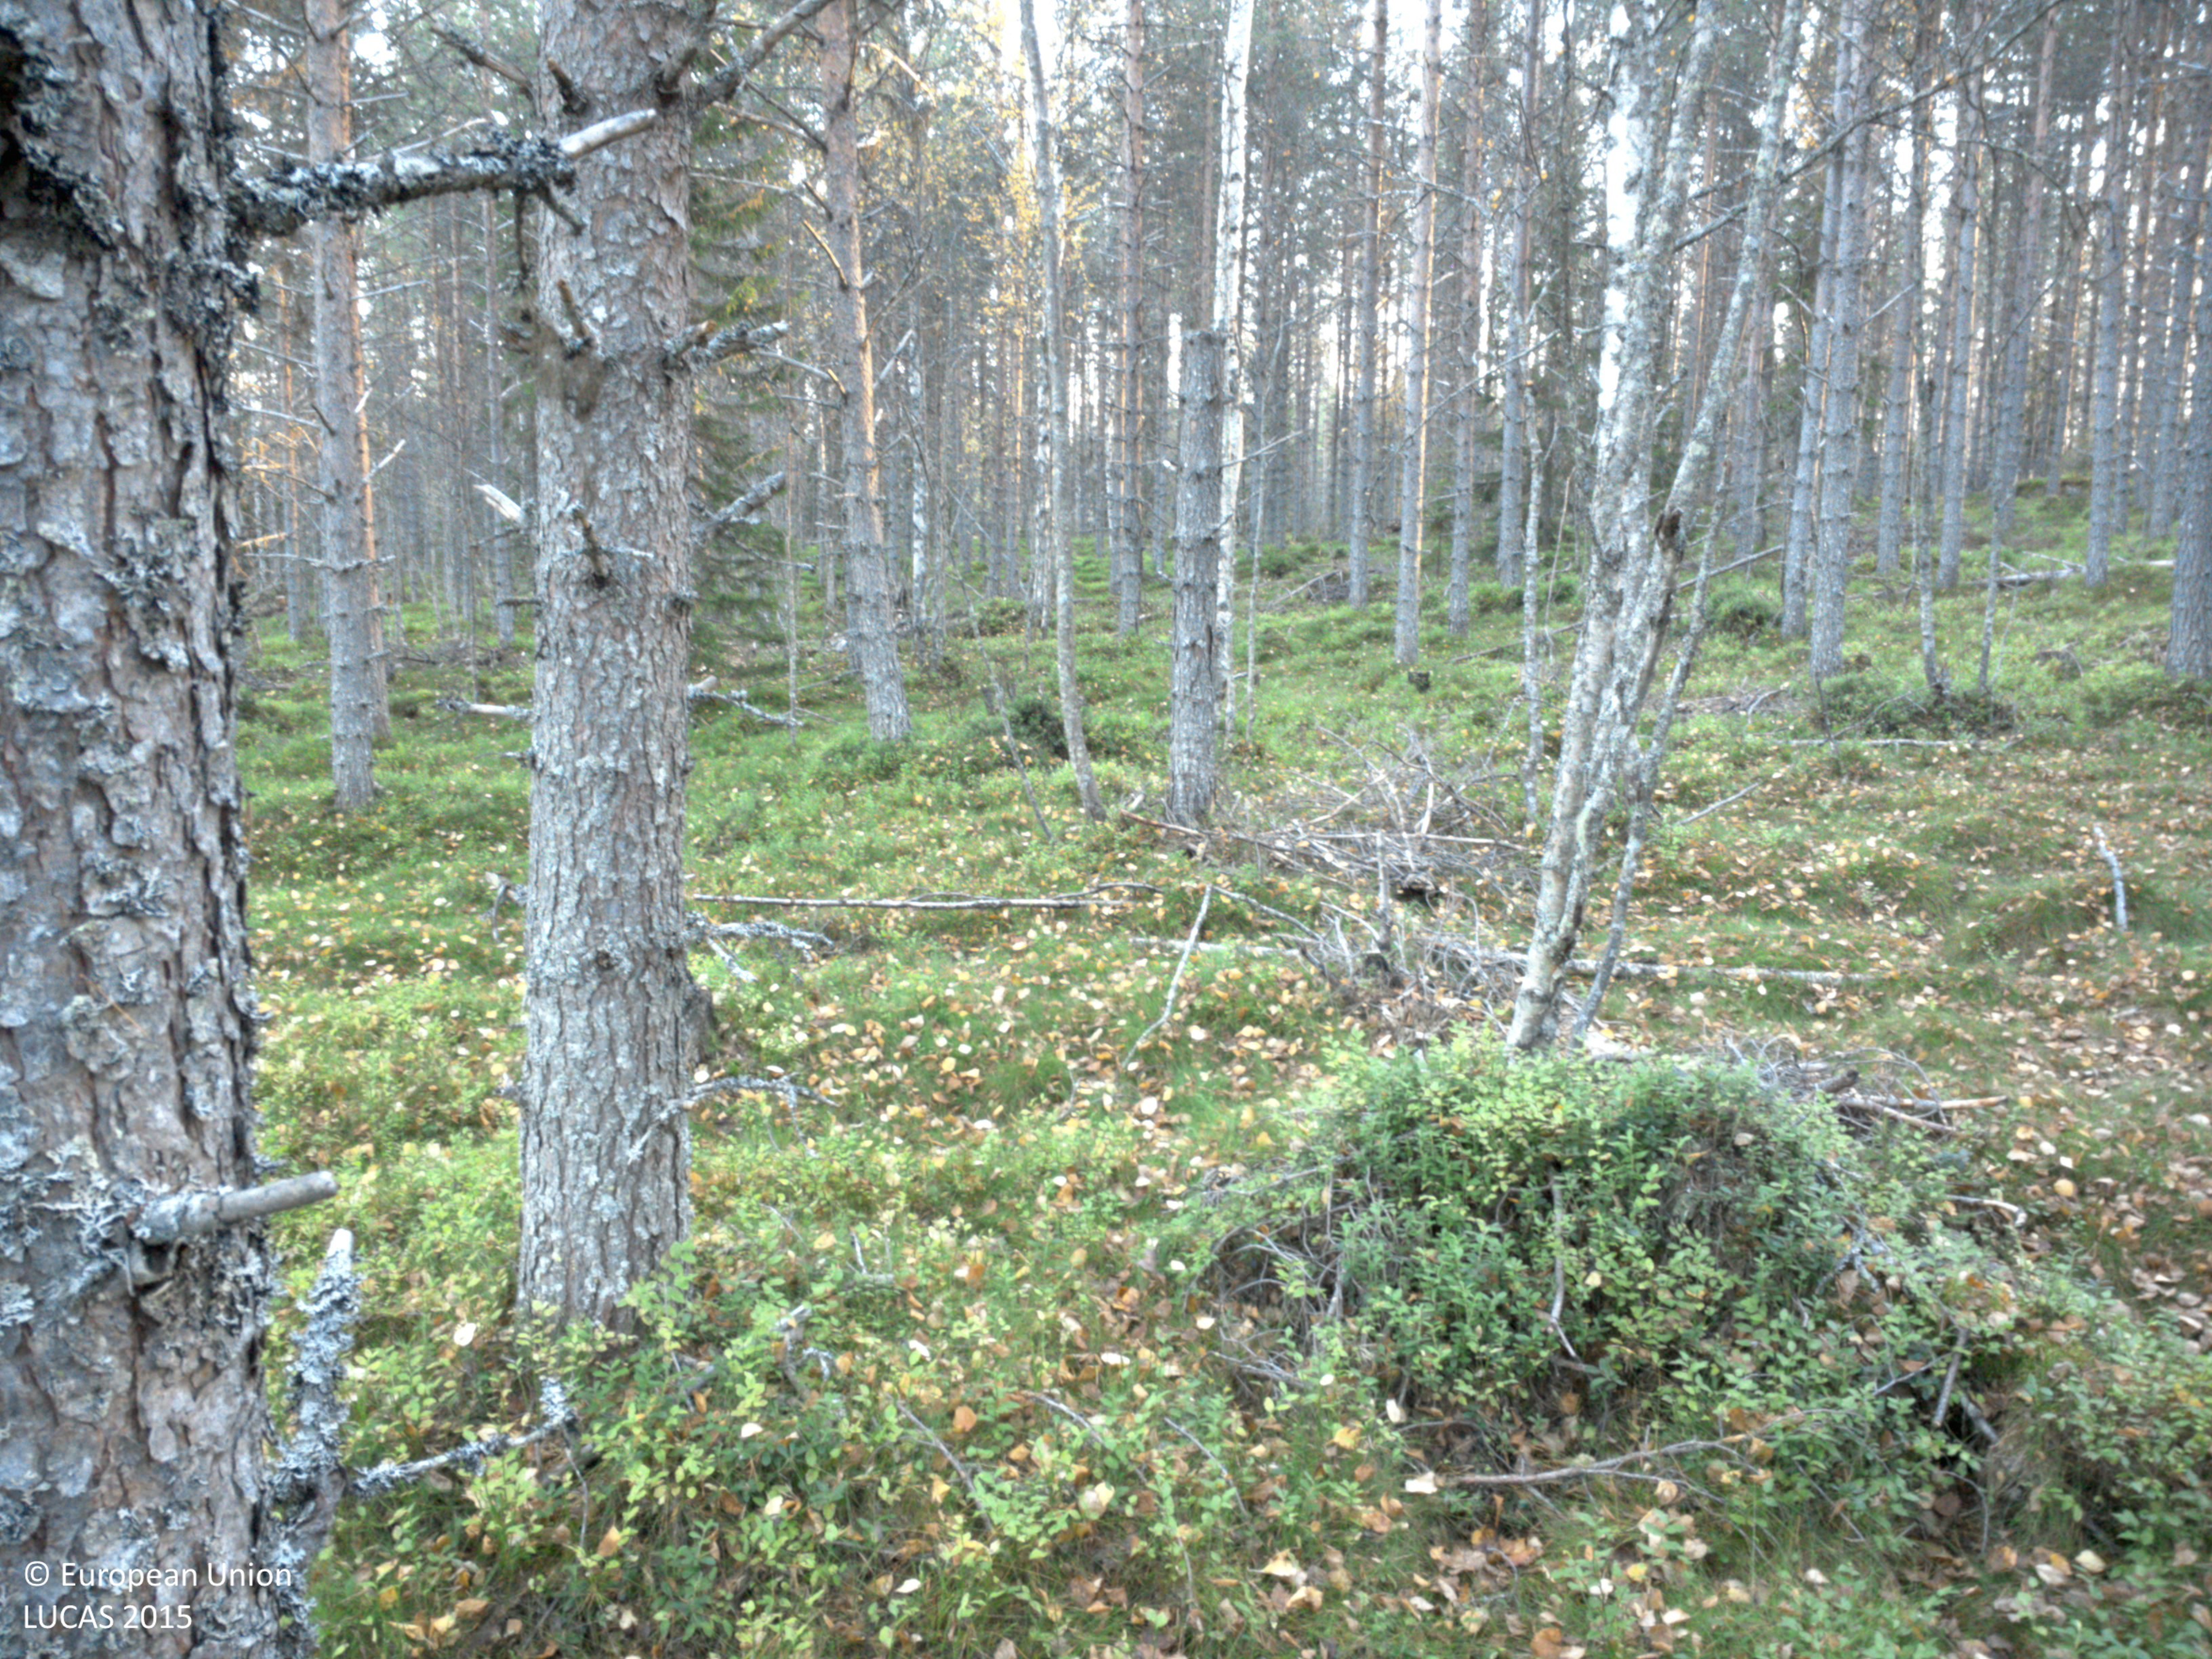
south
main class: Woodland
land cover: Pine dominated coniferous woodland
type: boreal forest
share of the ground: 50 - 75 %
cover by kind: coniferous forest trees 60 %, shrubs 20 %, lichens and mosses 15 %, broadleaved forest trees 5 %
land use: Forestry
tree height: > 5 m
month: October
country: SE
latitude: 64.7171
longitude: 17.7512
